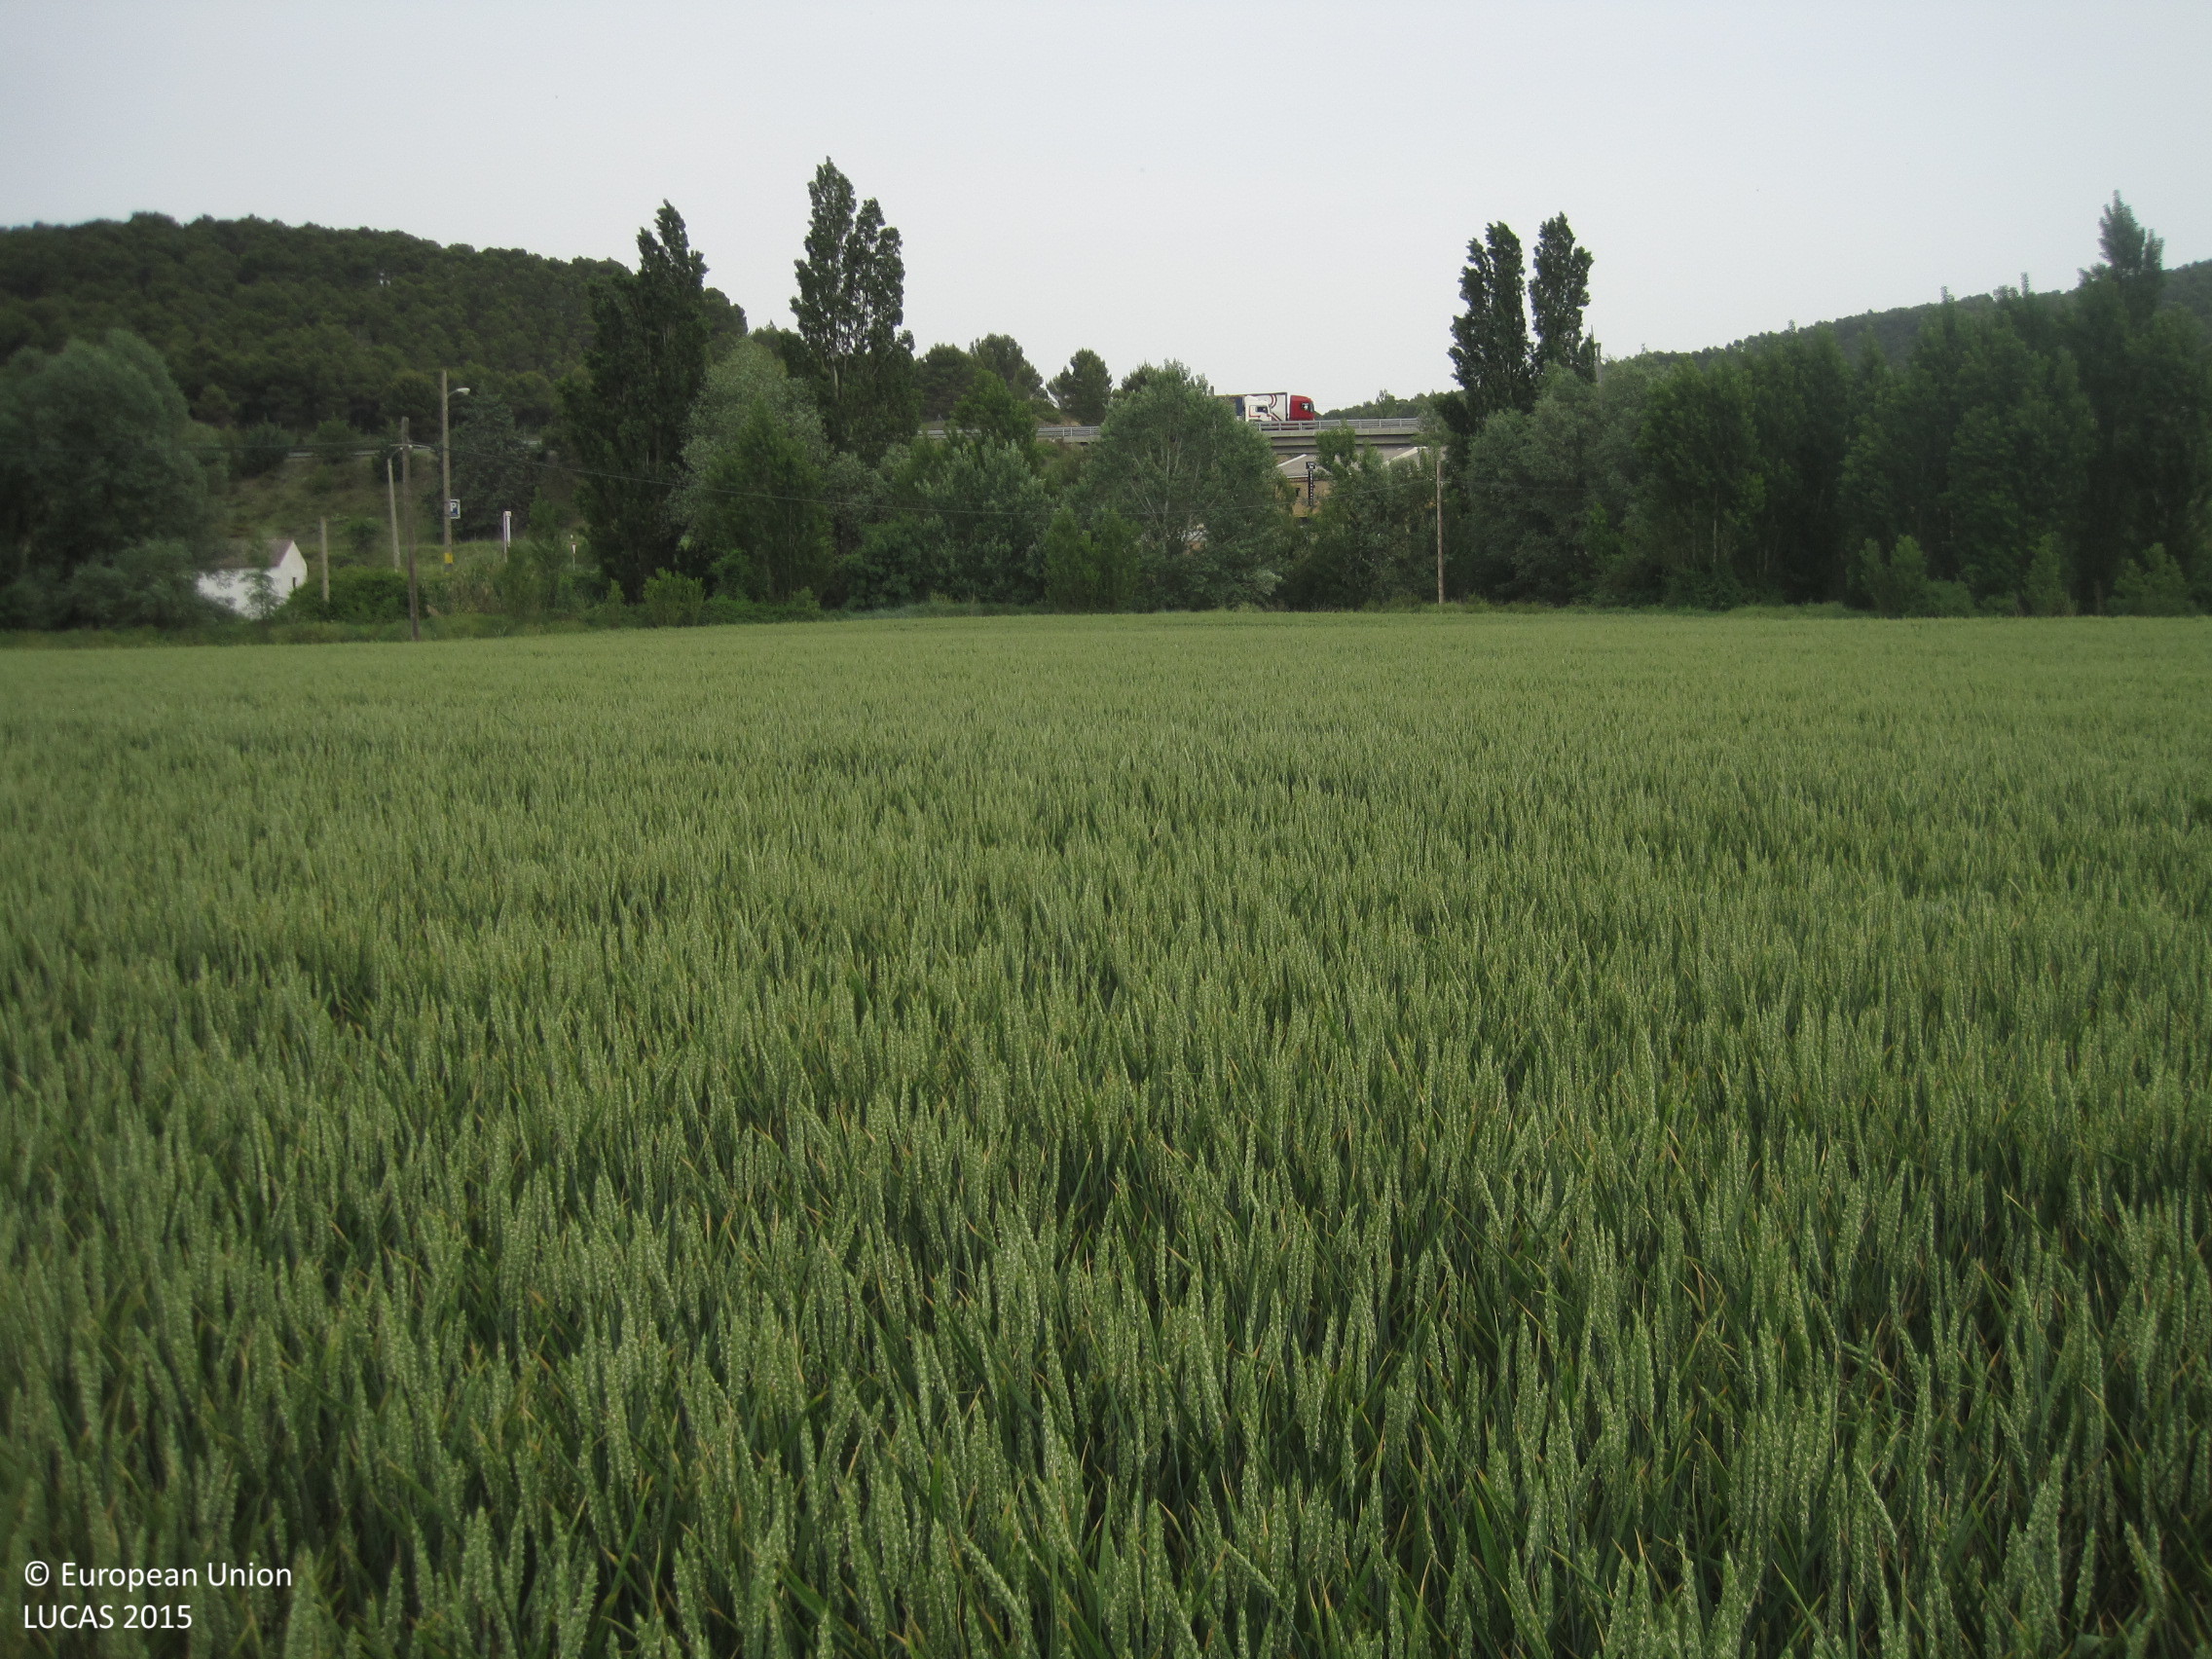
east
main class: Cropland
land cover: Common wheat
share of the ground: > 75 %
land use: Agriculture (excluding fallow land and kitchen gardens)
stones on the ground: < 10 %
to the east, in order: Common wheat; Grassland without tree/shrub cover; Broadleaved woodland; Inland fresh running water; Broadleaved woodland; Artificial constructions in urban areas; Paved roads, cycling and walking lanes; Artificial constructions in urban areas; Paved roads, cycling and walking lanes; Grassland without tree/shrub cover; Paved roads, cycling and walking lanes
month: May
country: ES
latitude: 42.5632
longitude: -1.6451
